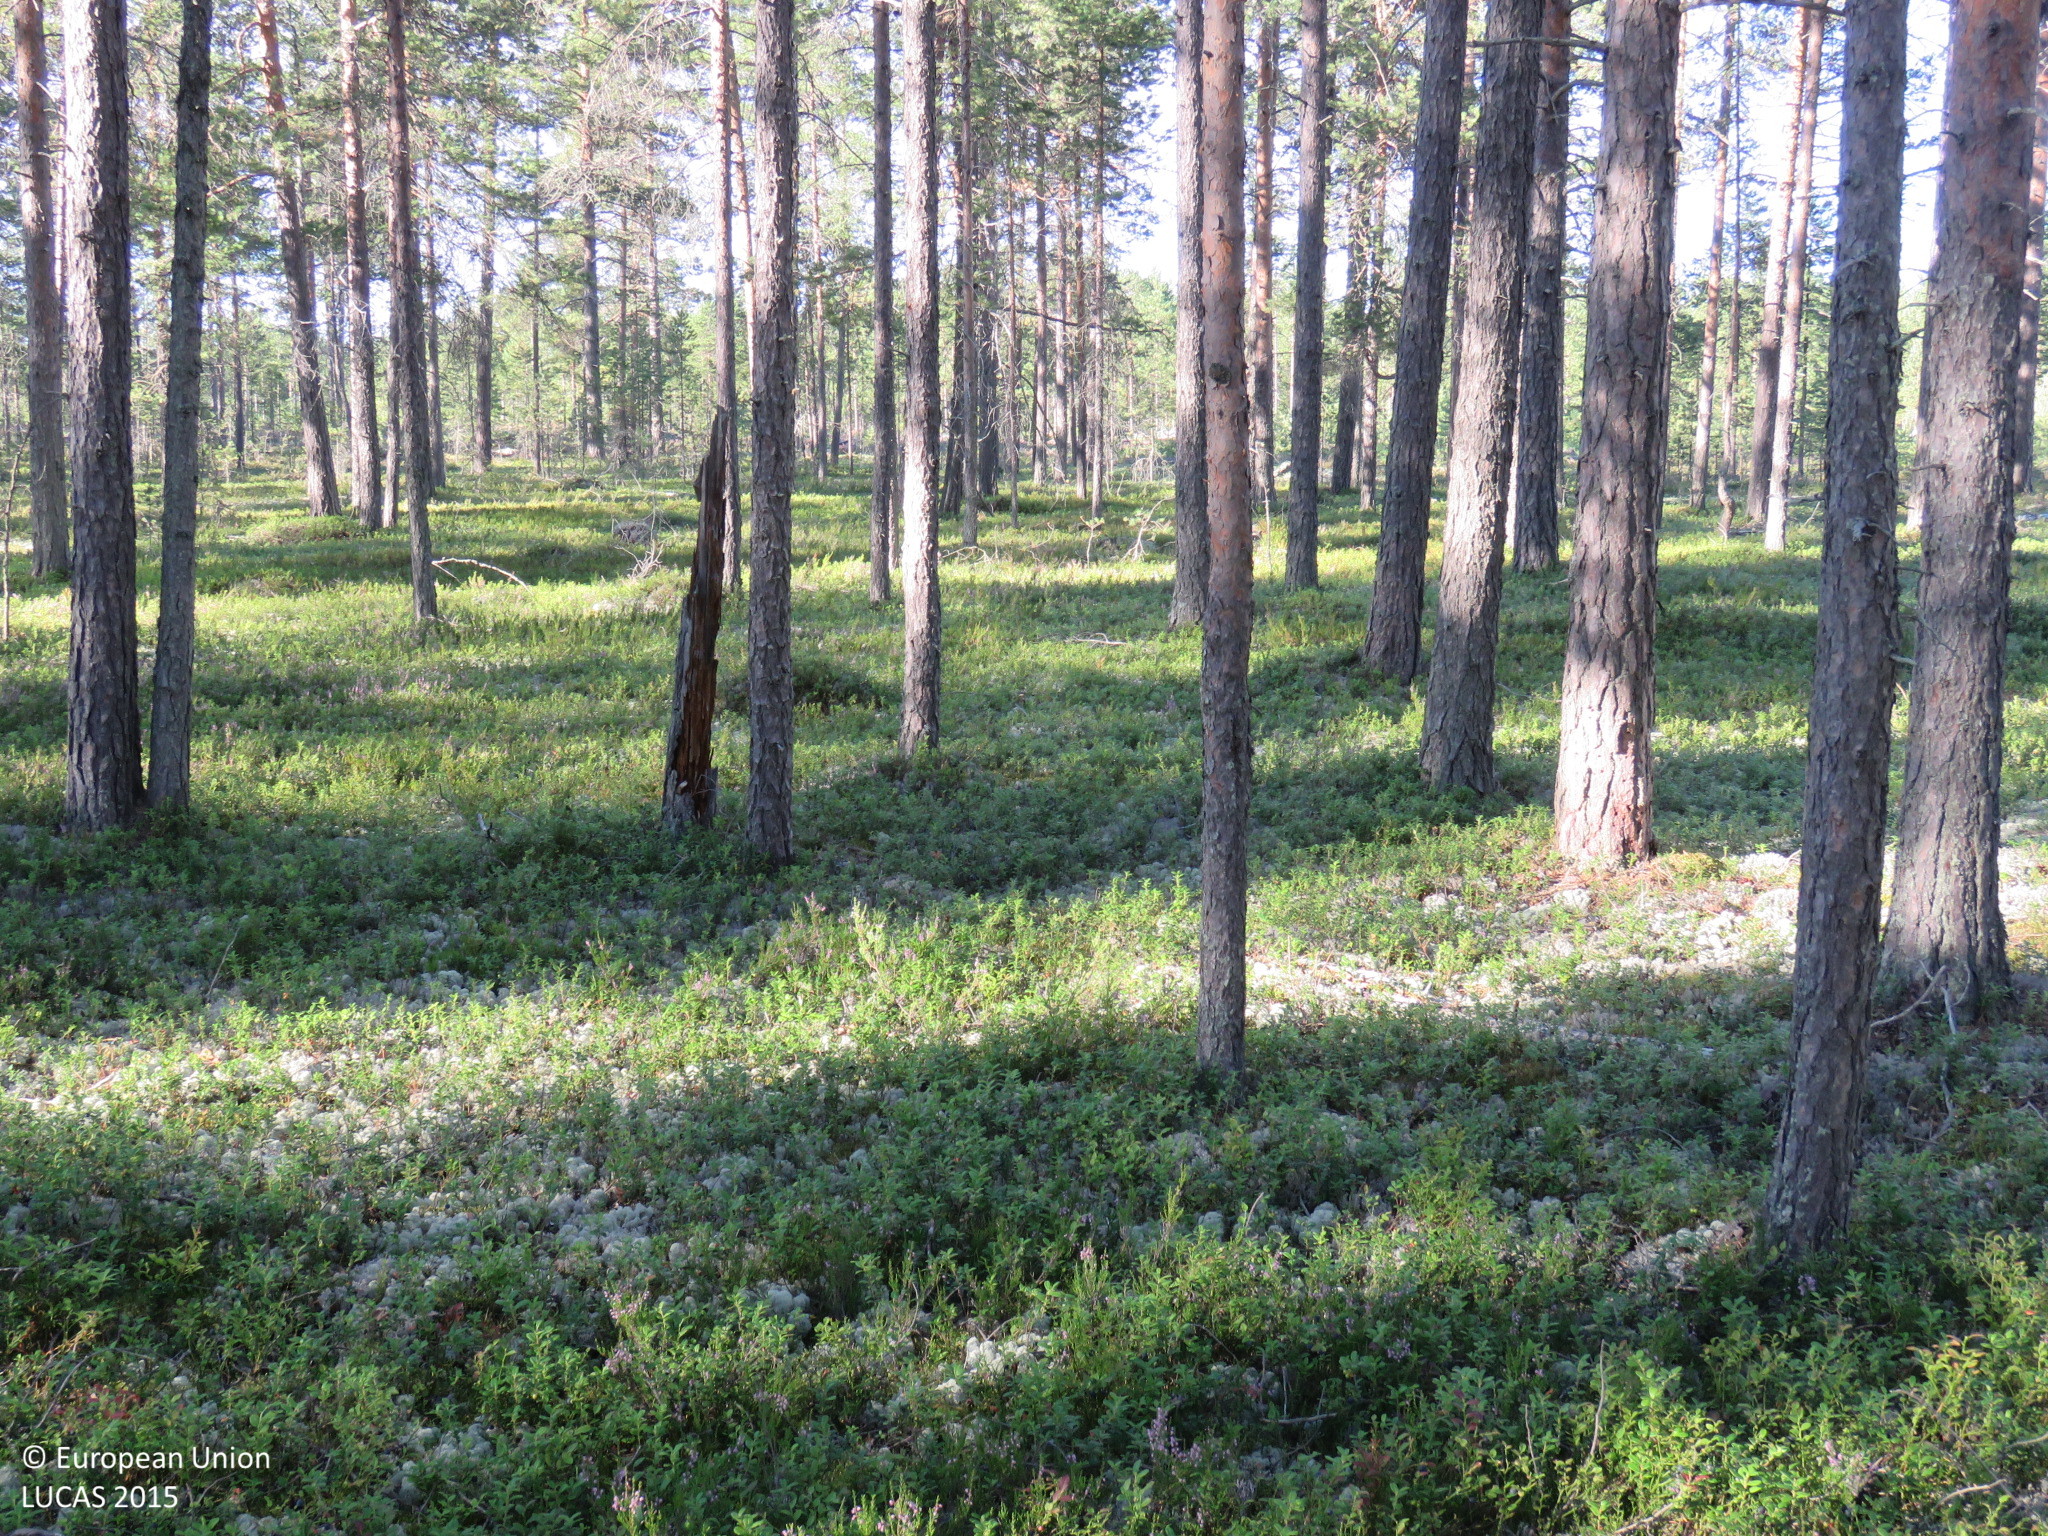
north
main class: Woodland
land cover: Pine dominated coniferous woodland
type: boreal forest
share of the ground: > 75 %
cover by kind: coniferous forest trees 75 %, shrubs 20 %, lichens and mosses 5 %
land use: Forestry
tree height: > 5 m
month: August
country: FI
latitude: 65.0407
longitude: 24.6570
